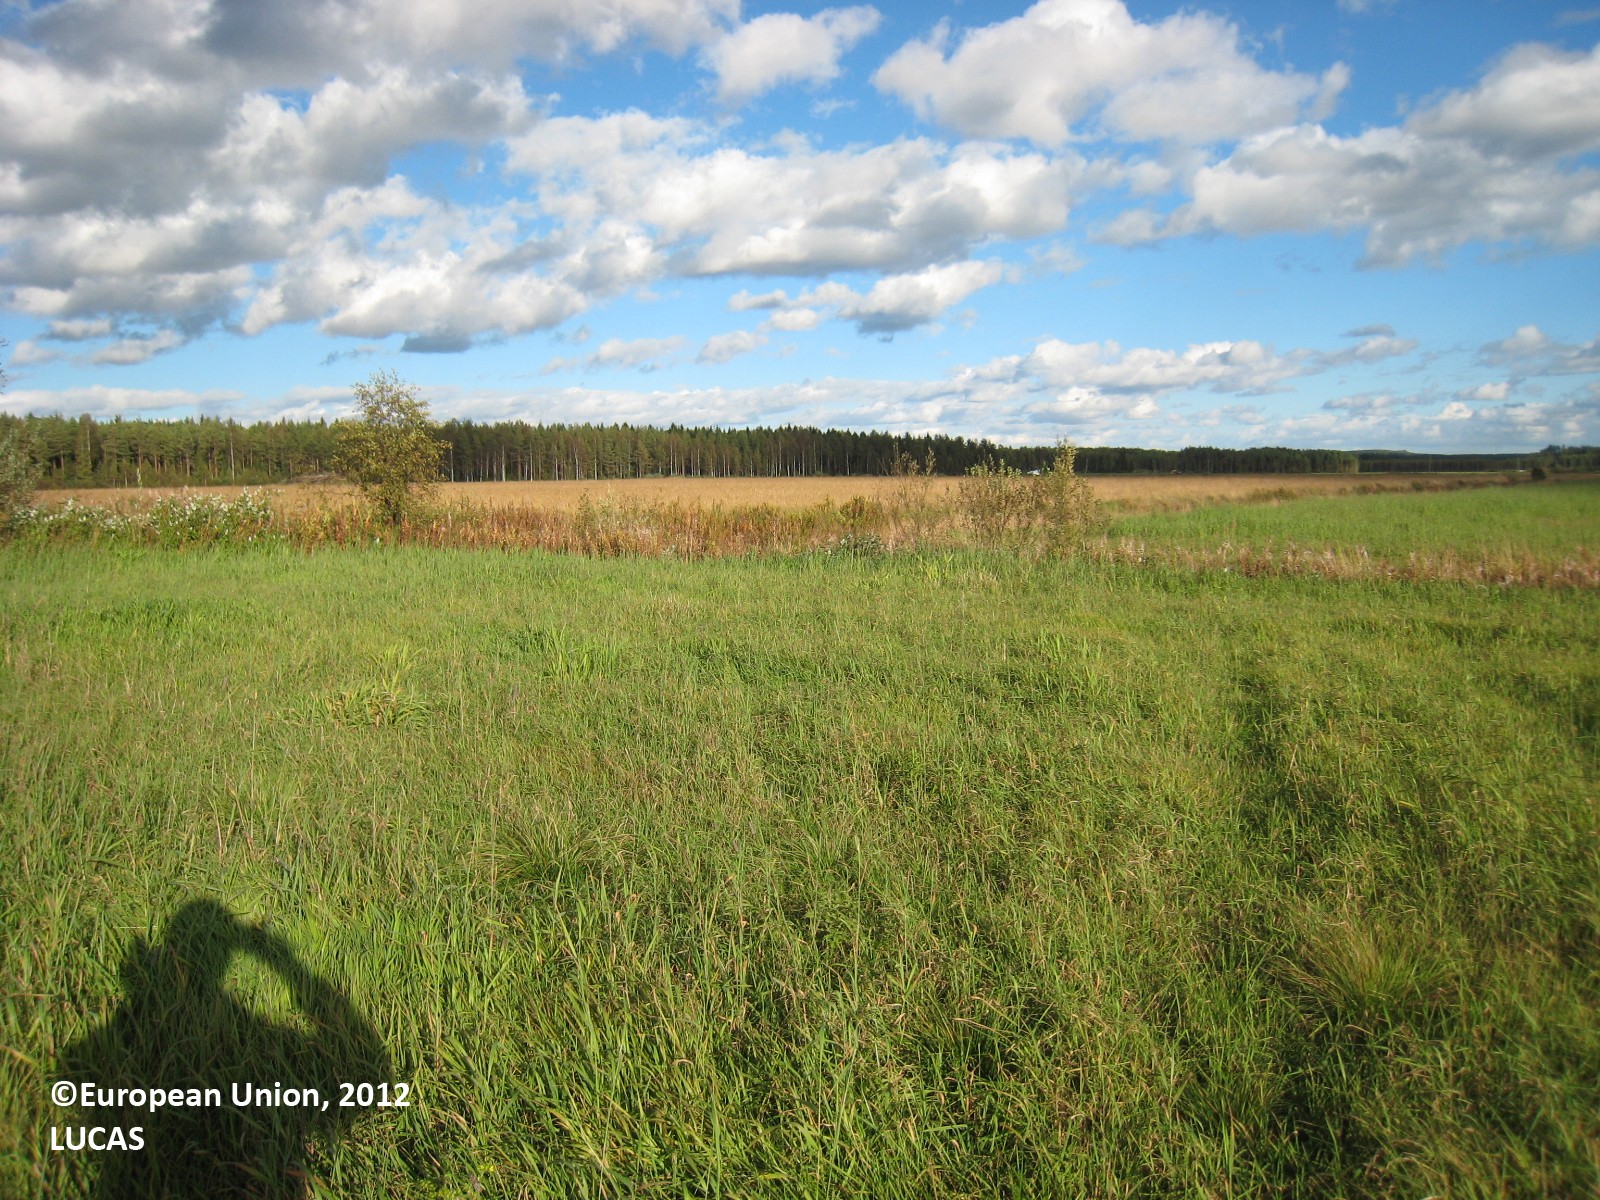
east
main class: Cropland
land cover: Temporary grasslands
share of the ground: > 75 %
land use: Agriculture (excluding fallow land and kitchen gardens)
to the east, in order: Temporary grasslands; Shruby margins; Ditches and canals; Grassland without tree/shrub cover; Temporary grasslands; Abandoned hedges; Ditches and canals; Abandoned hedges; Temporary grasslands
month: September
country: FI
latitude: 63.1113
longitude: 26.8891
